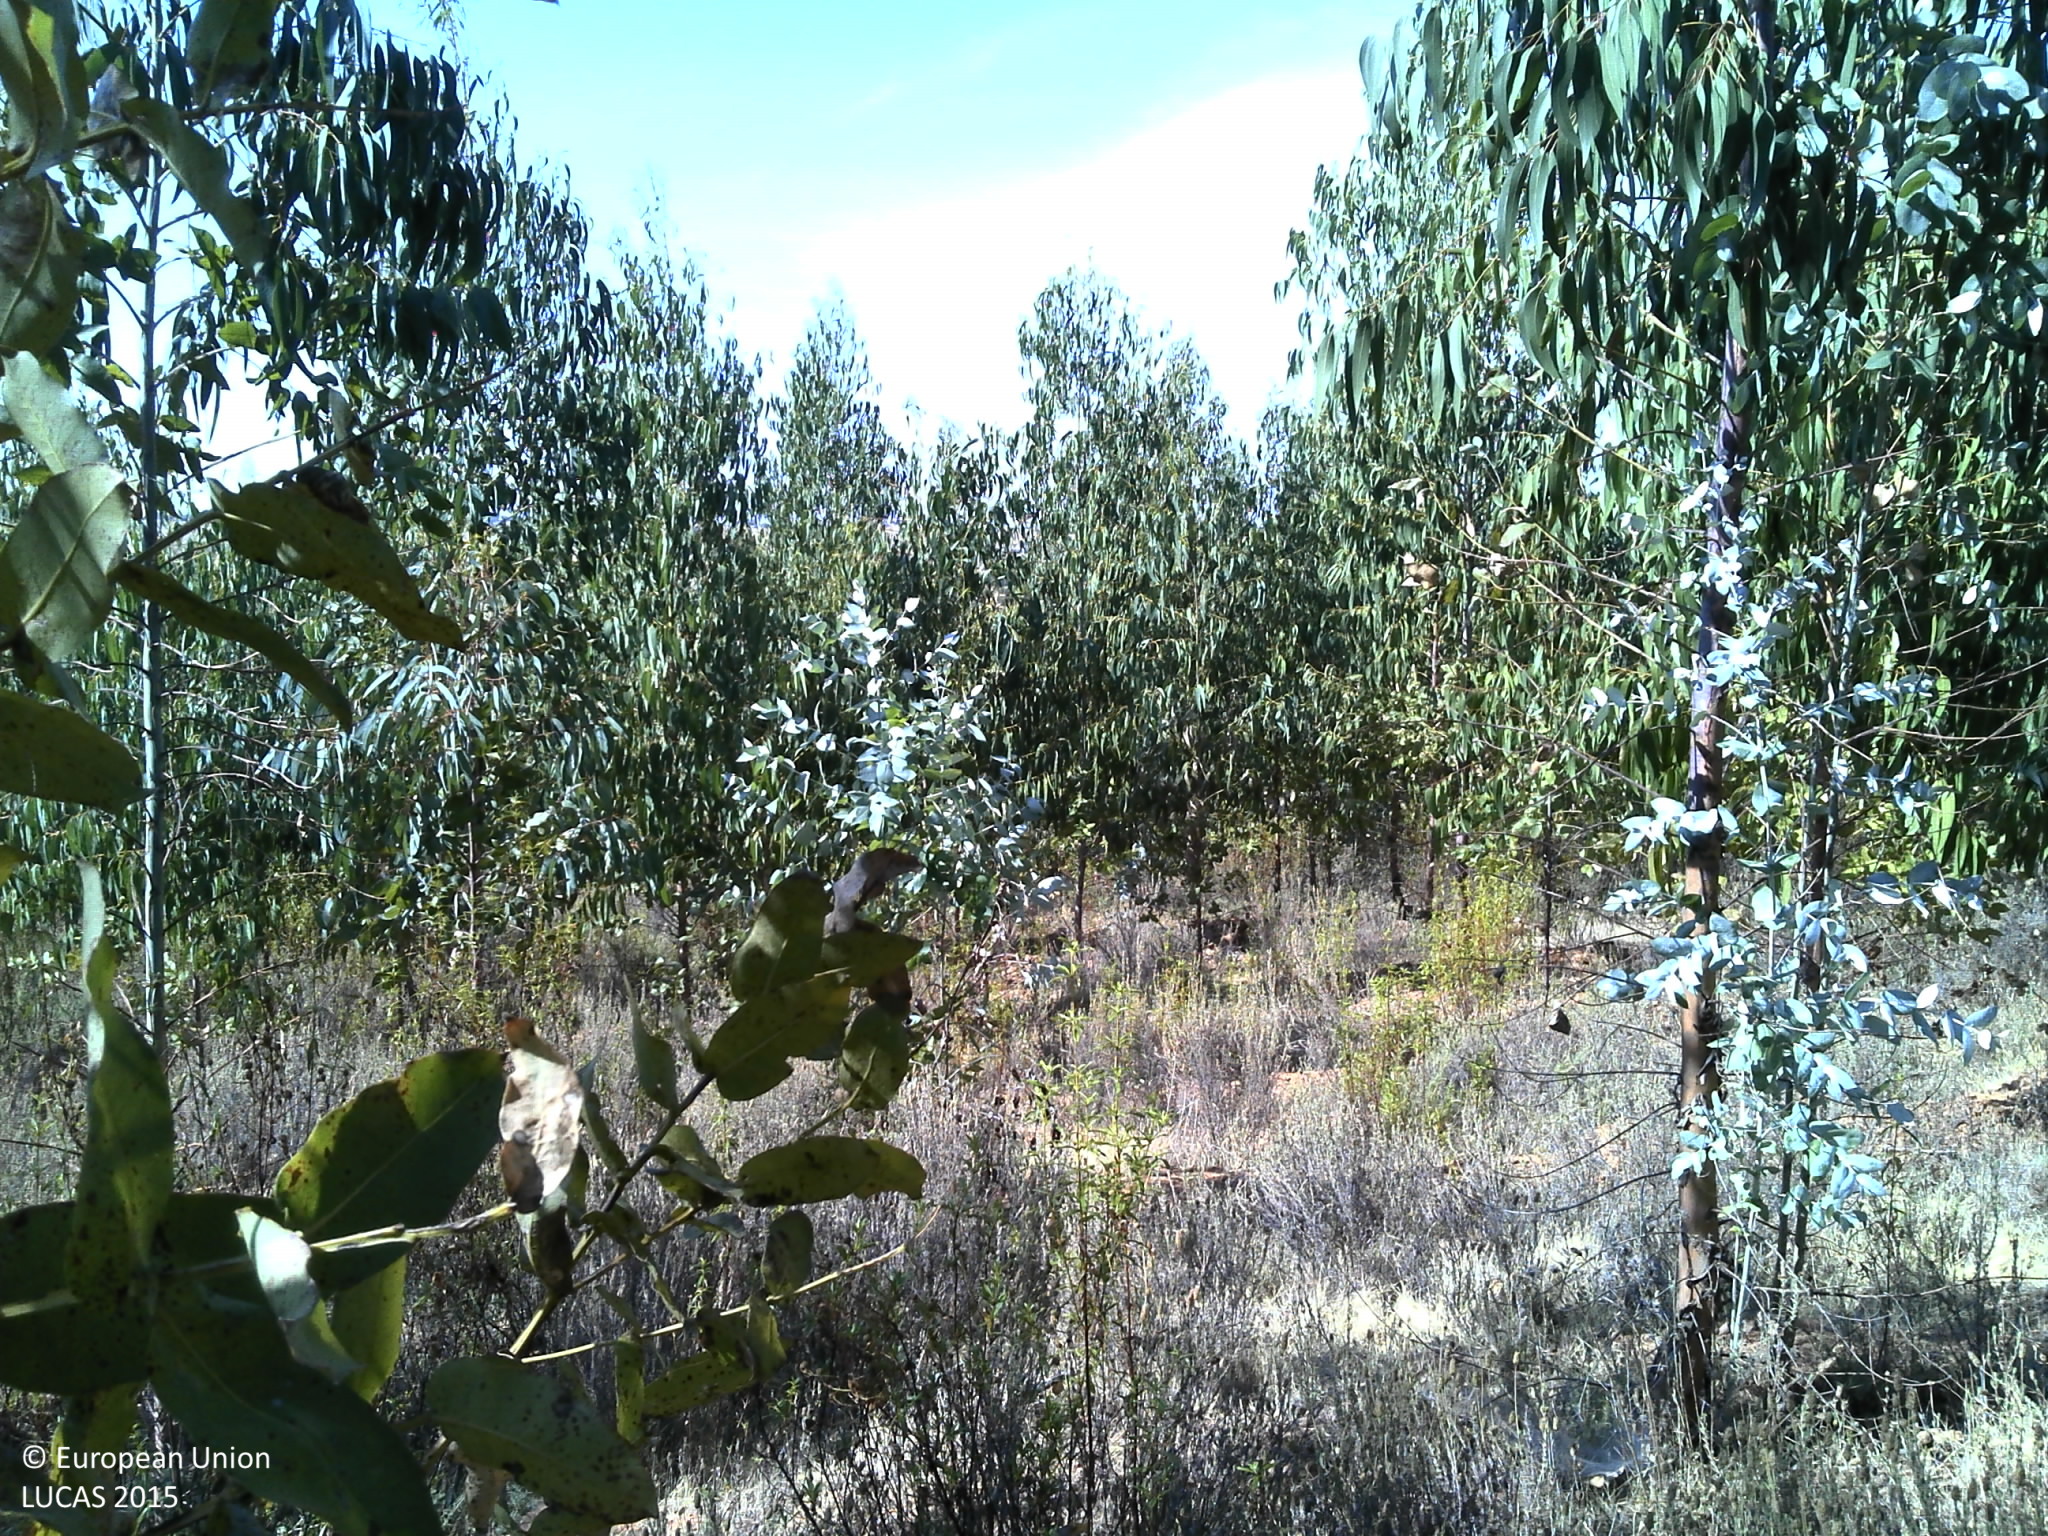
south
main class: Woodland
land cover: Broadleaved woodland
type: exotic forest
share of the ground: 25 - 50 %
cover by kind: broadleaved forest trees 40 %, shrubs 40 %, unconsolidated bare surface 20 %
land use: Forestry
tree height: > 5 m
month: July
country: PT
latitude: 38.6114
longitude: -7.4744
